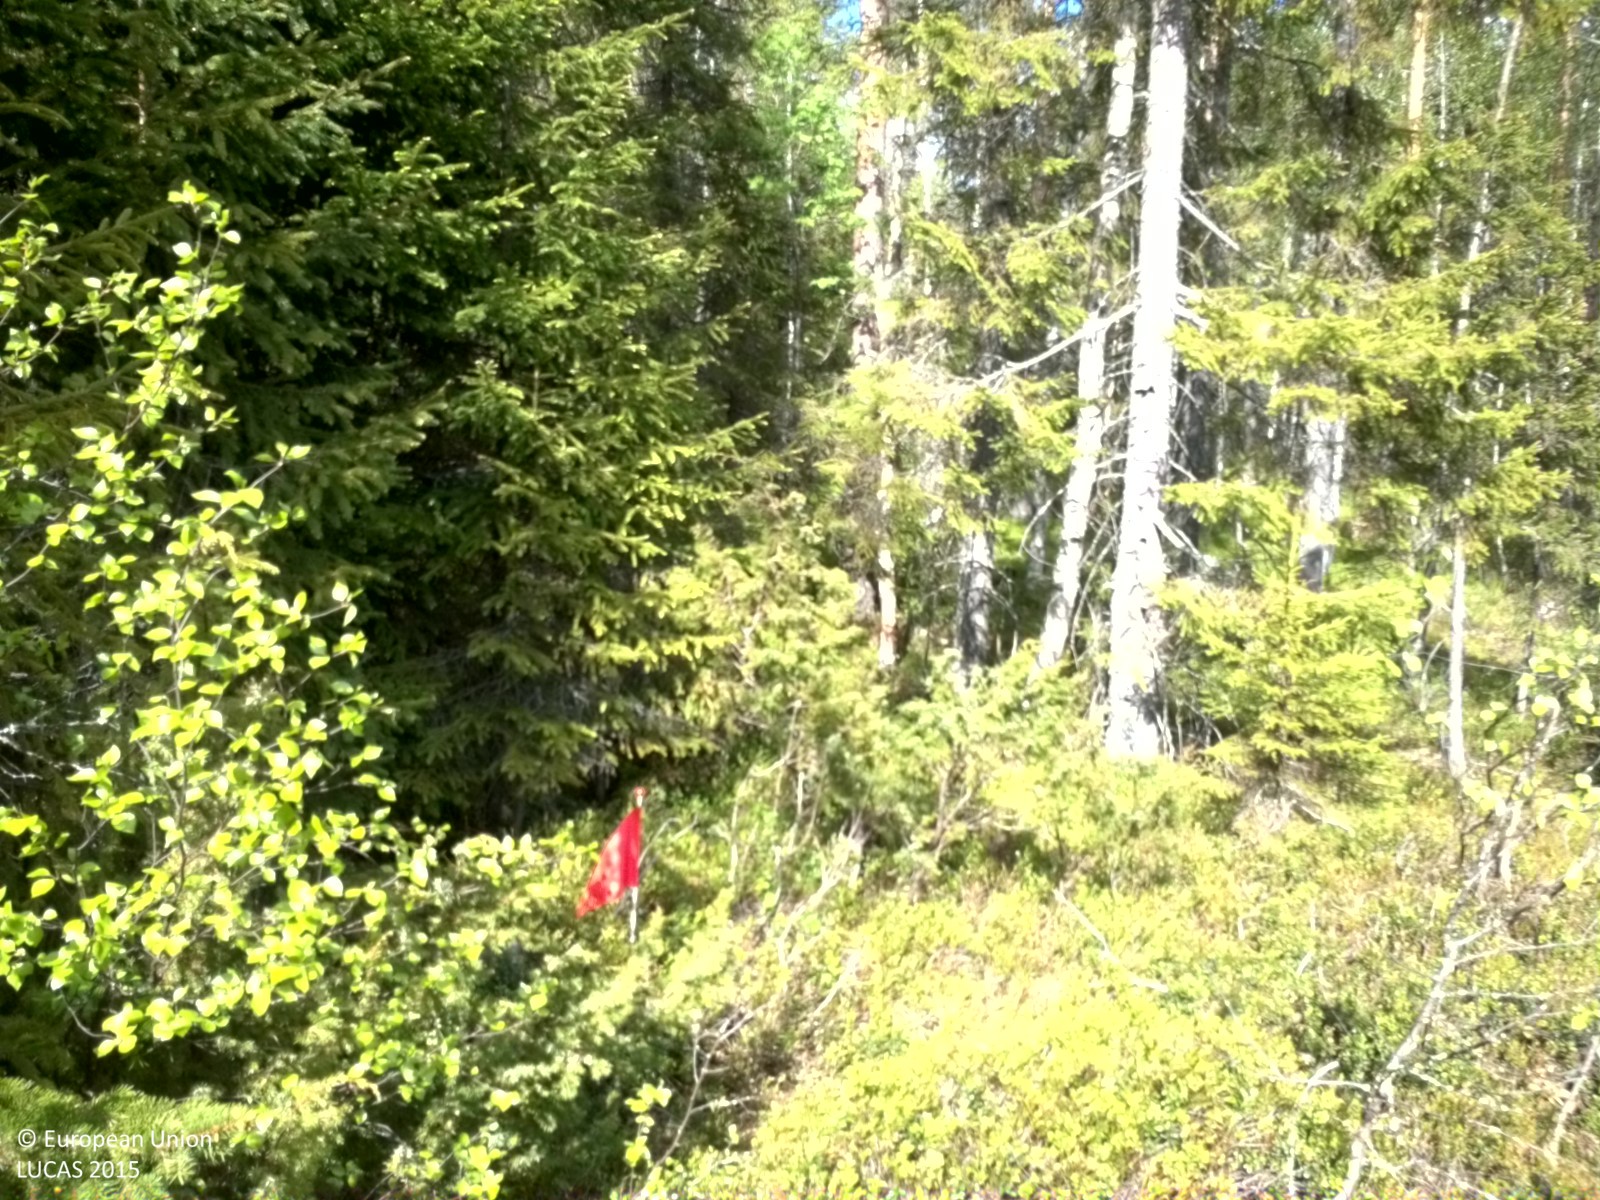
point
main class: Woodland
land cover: Spruce dominated mixed woodland
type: boreal forest
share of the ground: 50 - 75 %
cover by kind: herbaceous plants 50 %, coniferous forest trees 30 %, broadleaved forest trees 20 %
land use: Forestry
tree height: > 5 m
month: June
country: SE
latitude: 63.9490
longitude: 20.0819
